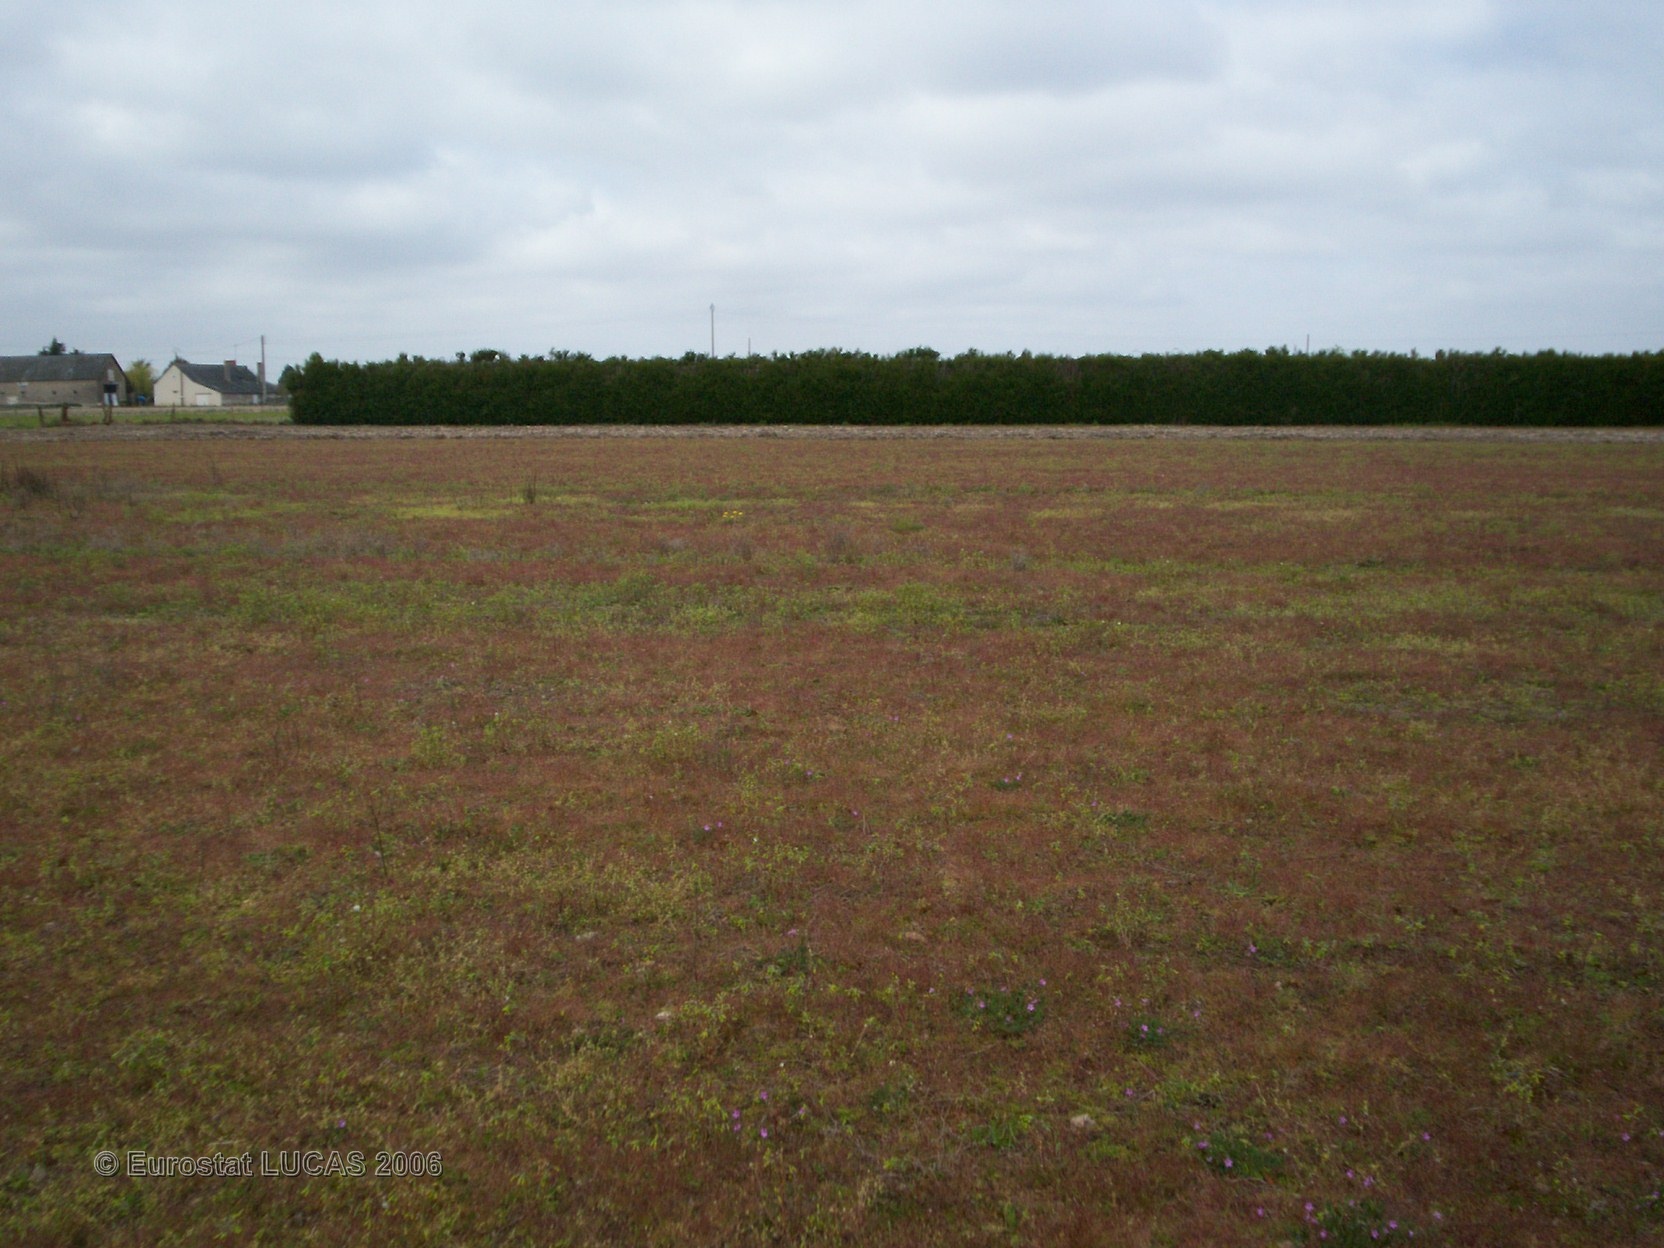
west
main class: Grassland
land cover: Grassland without tree/shrub cover
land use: Agriculture (excluding fallow land and kitchen gardens)
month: April
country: FR
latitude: 47.4566
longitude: -0.4159
